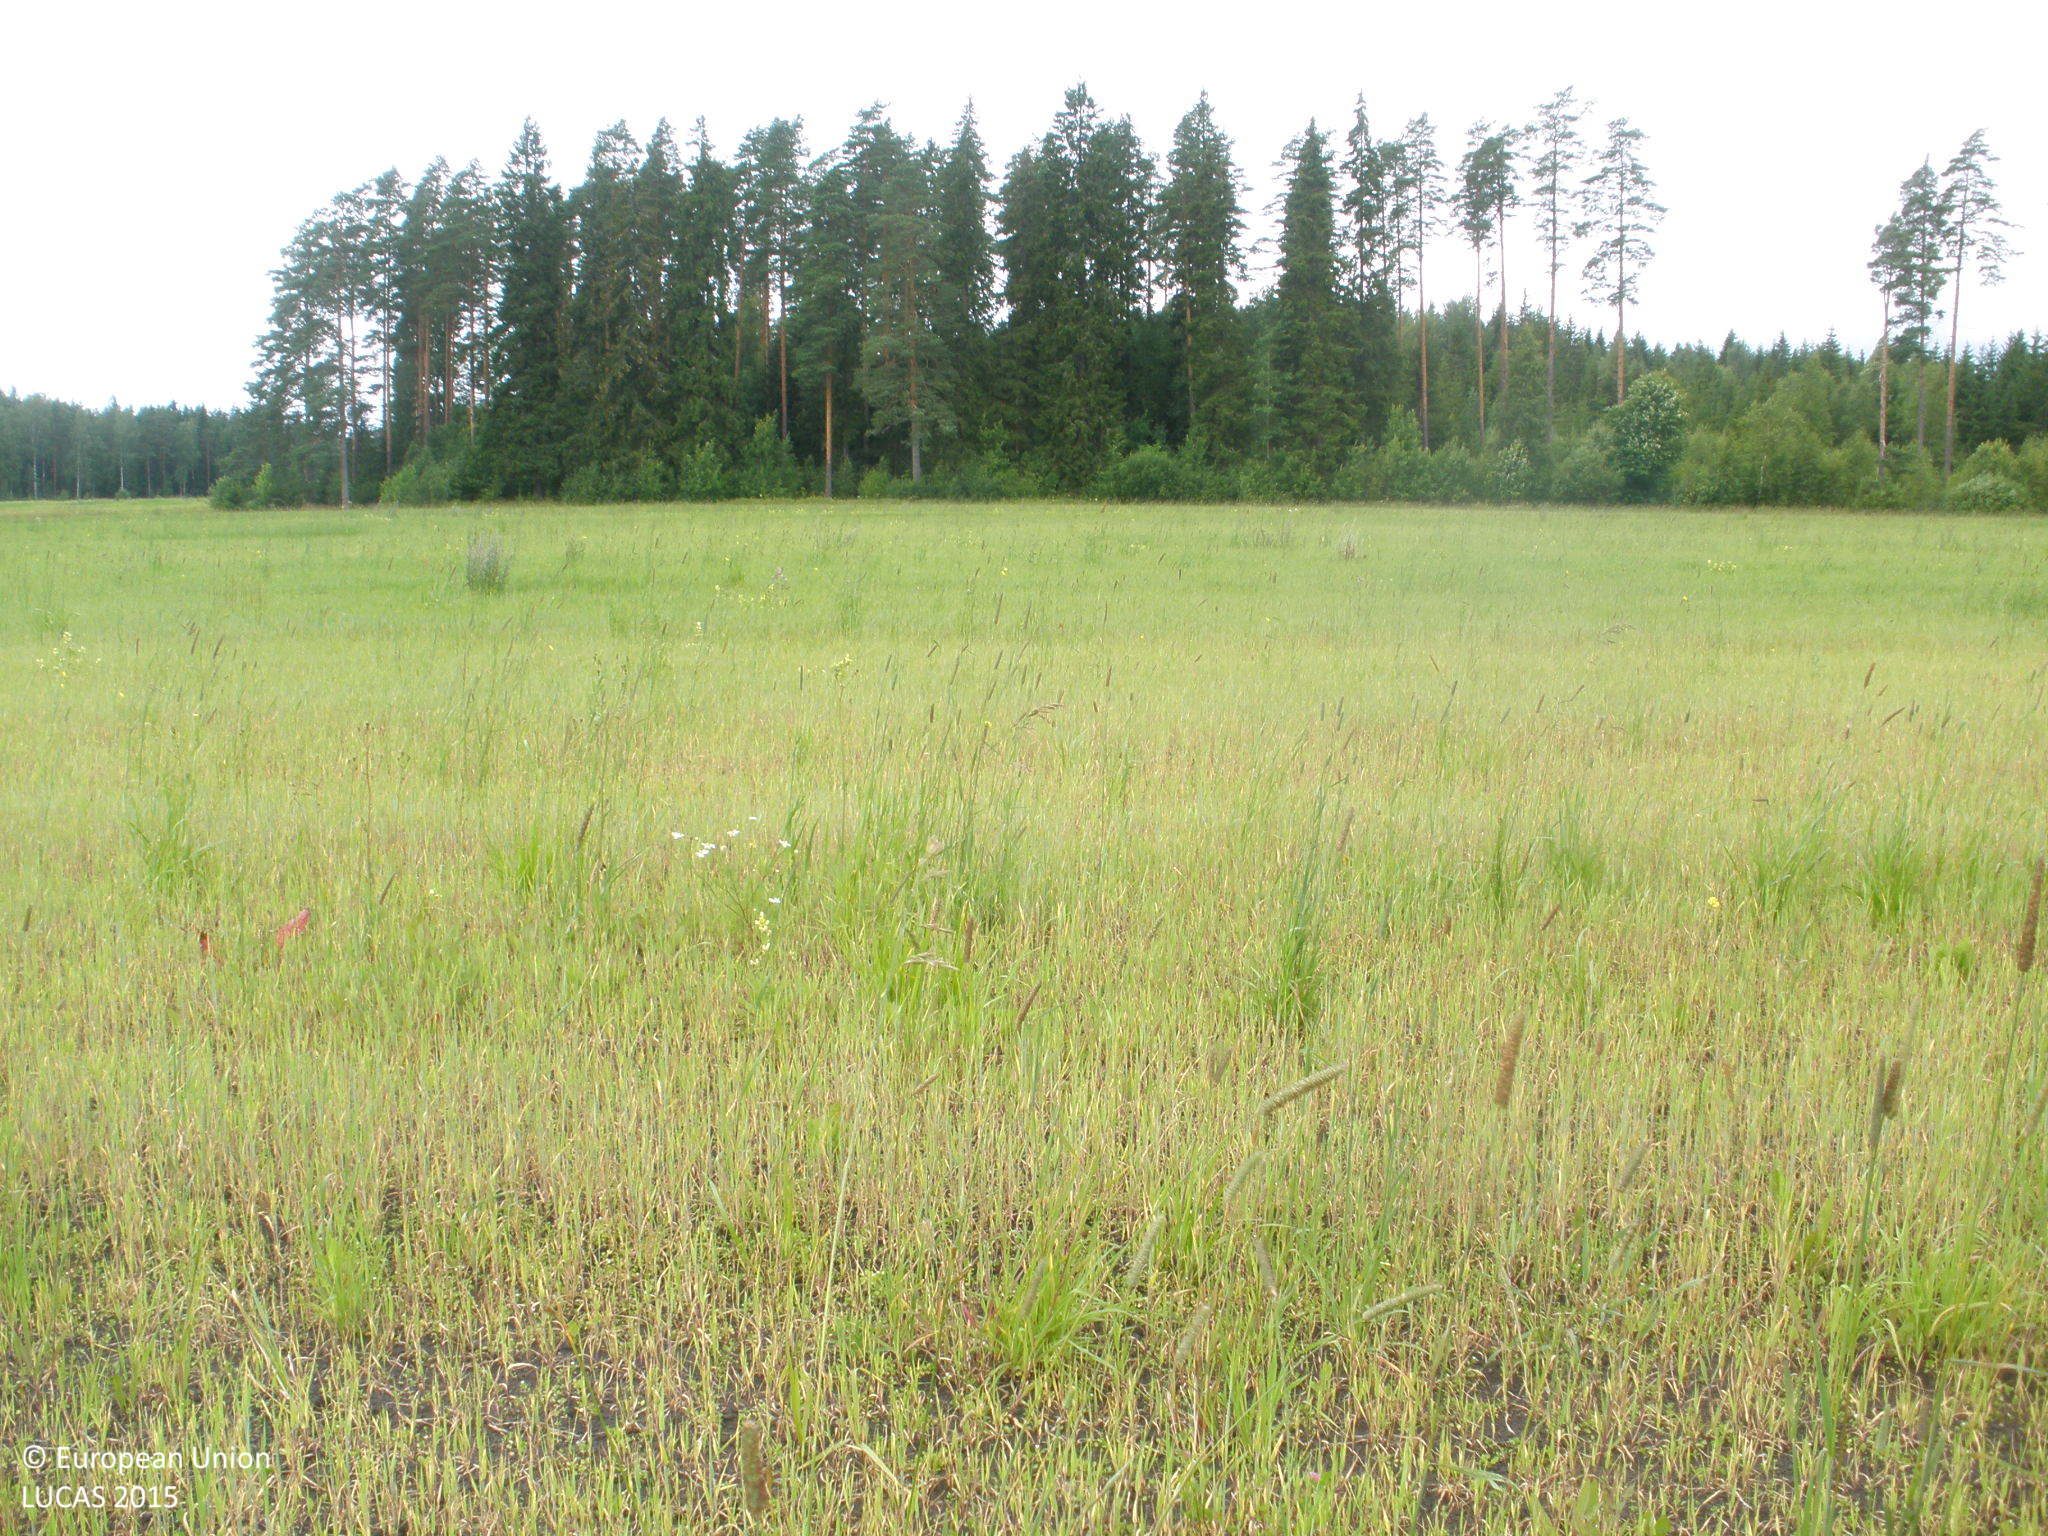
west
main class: Cropland
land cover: Barley
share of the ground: 10 - 25 %
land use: Agriculture (excluding fallow land and kitchen gardens)
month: July
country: FI
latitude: 60.6101
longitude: 23.4755
